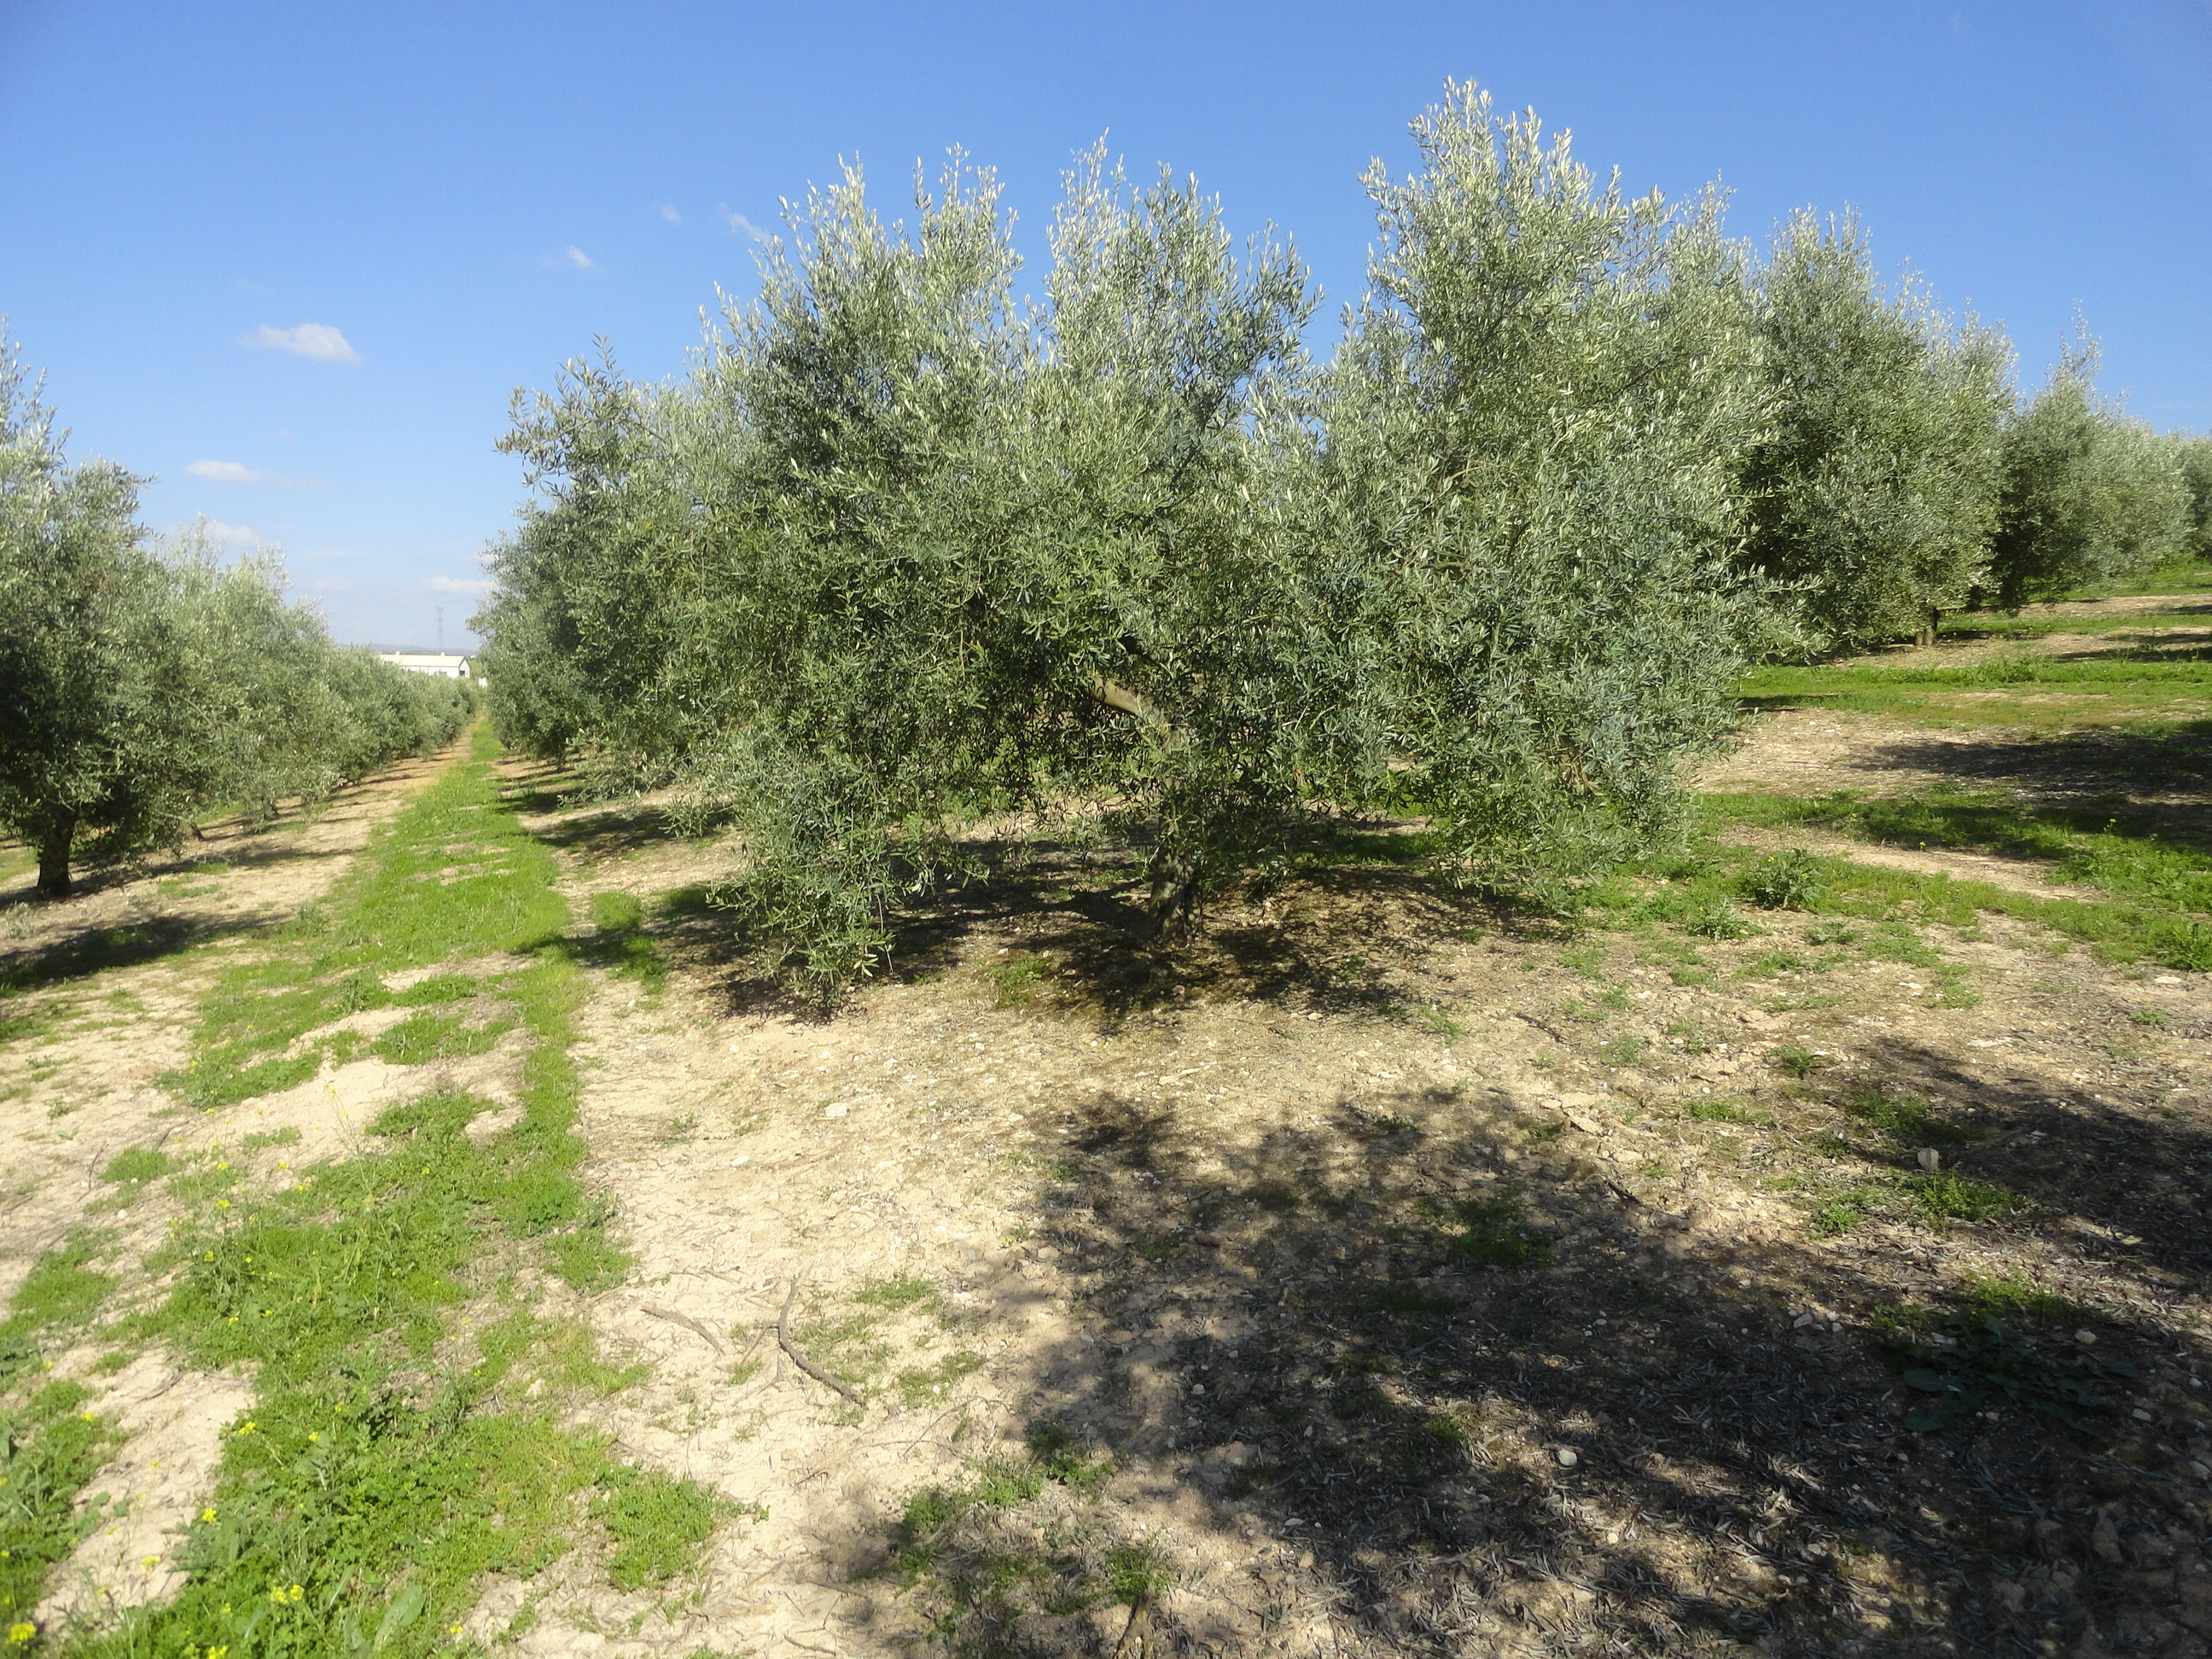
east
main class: Cropland
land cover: Olive groves
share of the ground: 50 - 75 %
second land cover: Spontaneously vegetated surfaces
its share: 25 - 50 %
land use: Agriculture (excluding fallow land and kitchen gardens)
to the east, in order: Olive groves; Spontaneously vegetated surfaces; Tracks; Vineyards
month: April
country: ES
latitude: 37.5129
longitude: -4.4970
